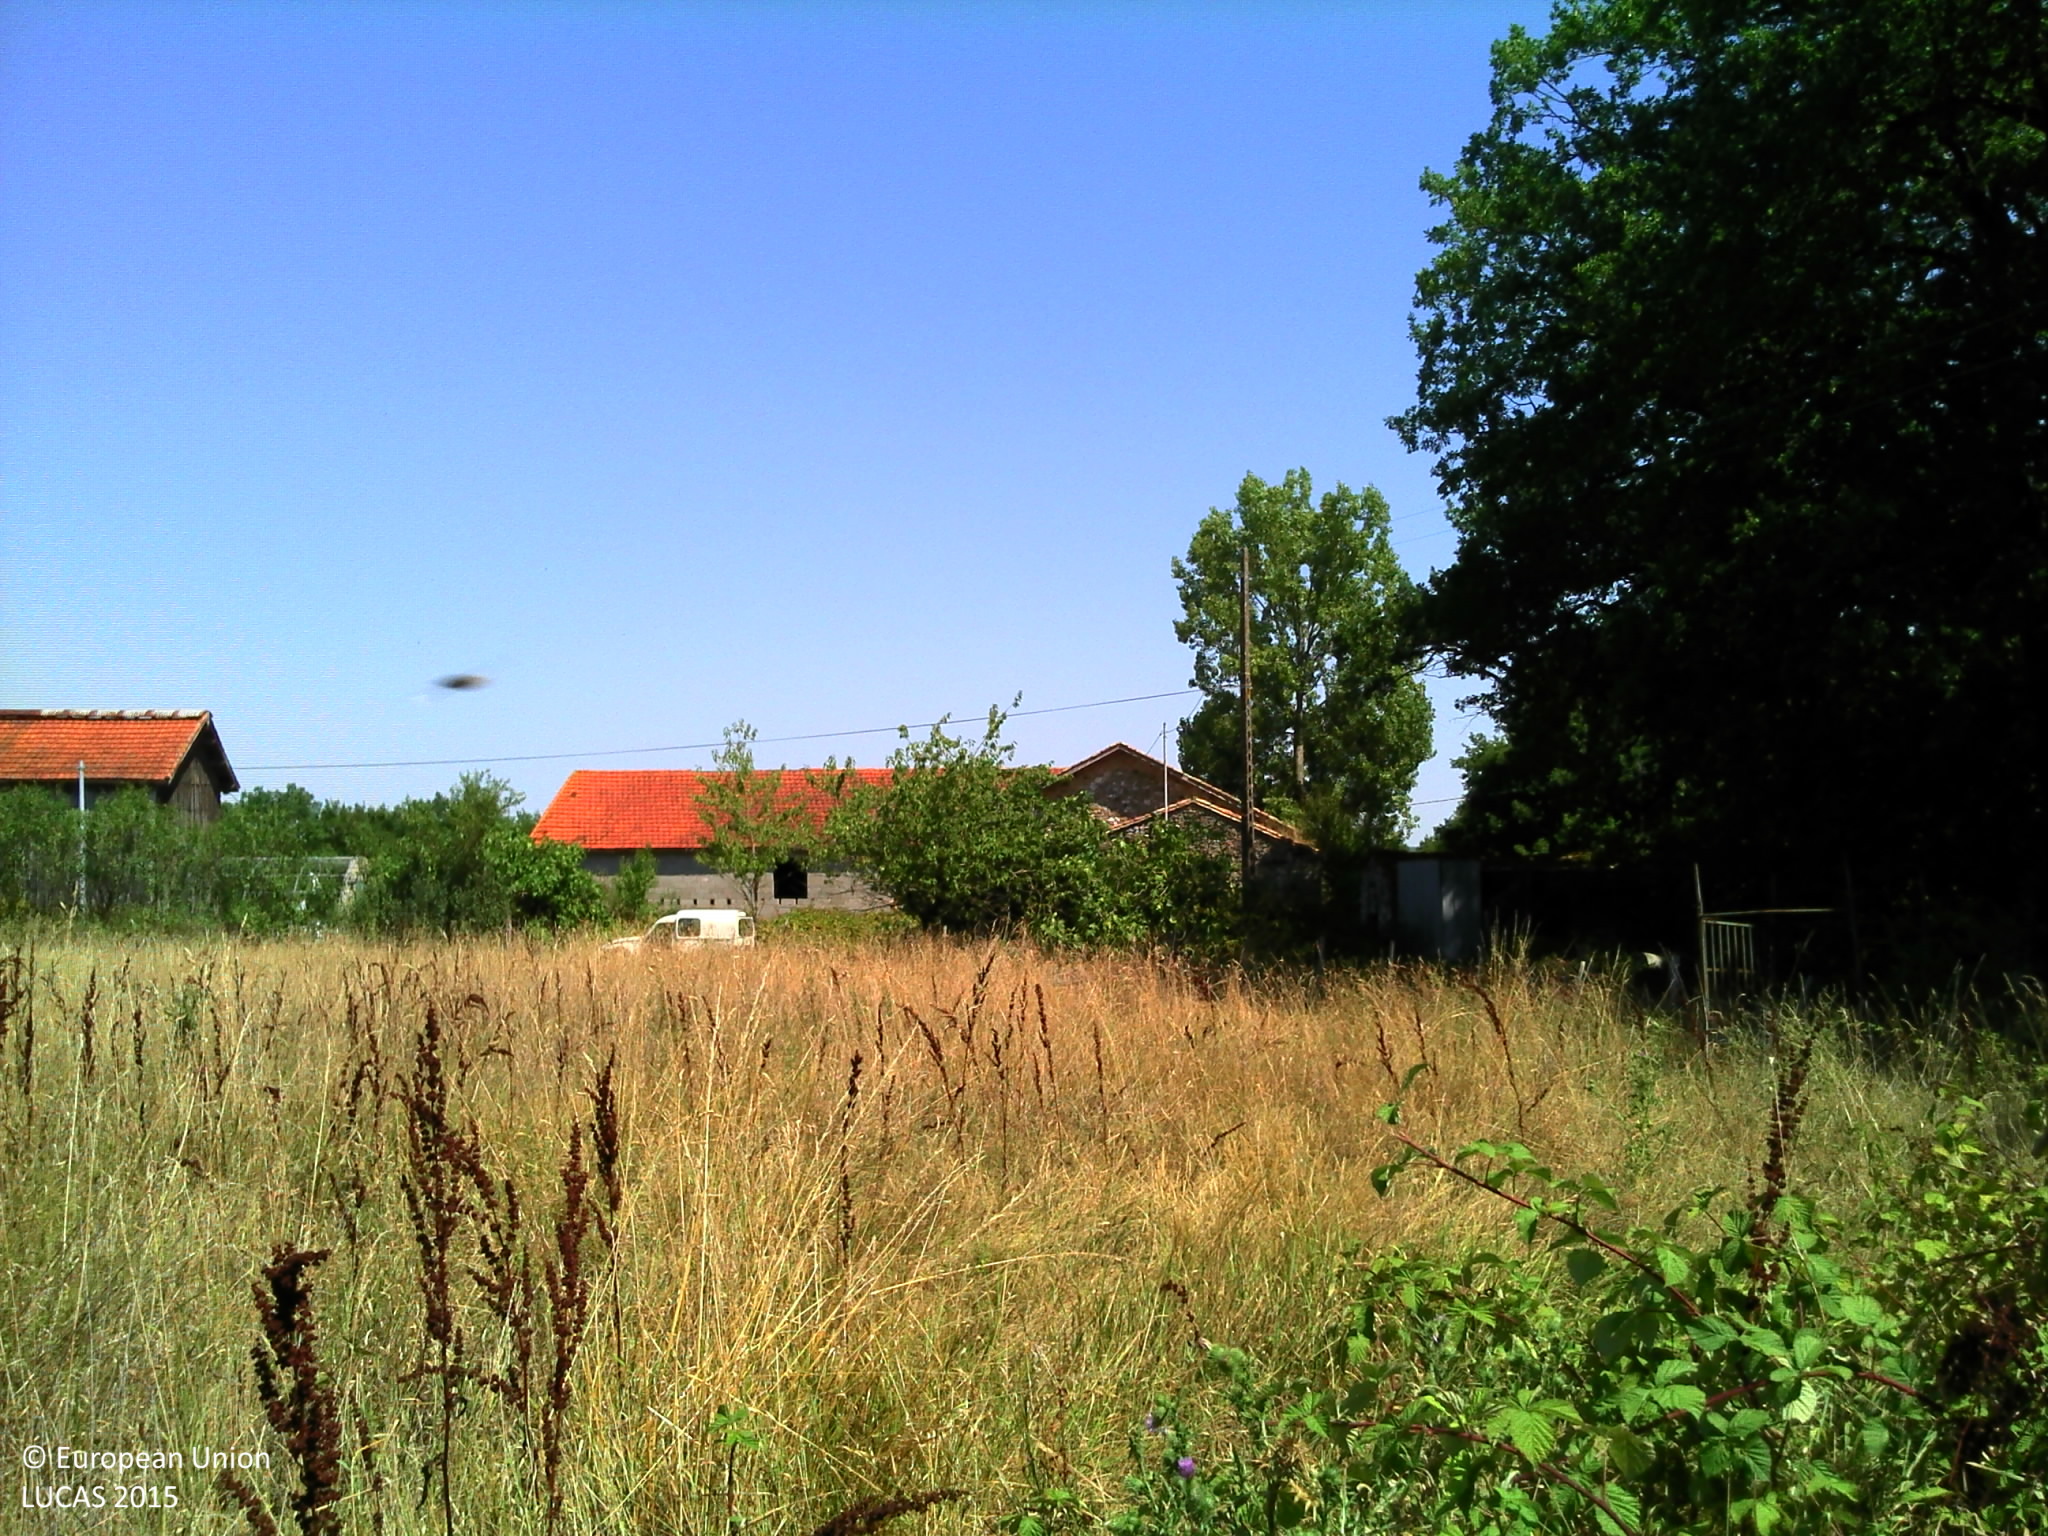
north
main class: Grassland
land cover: Spontaneously vegetated surfaces
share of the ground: > 75 %
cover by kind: herbaceous plants 100 %
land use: Fallow land
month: August
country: FR
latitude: 44.7403
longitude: 0.8117
